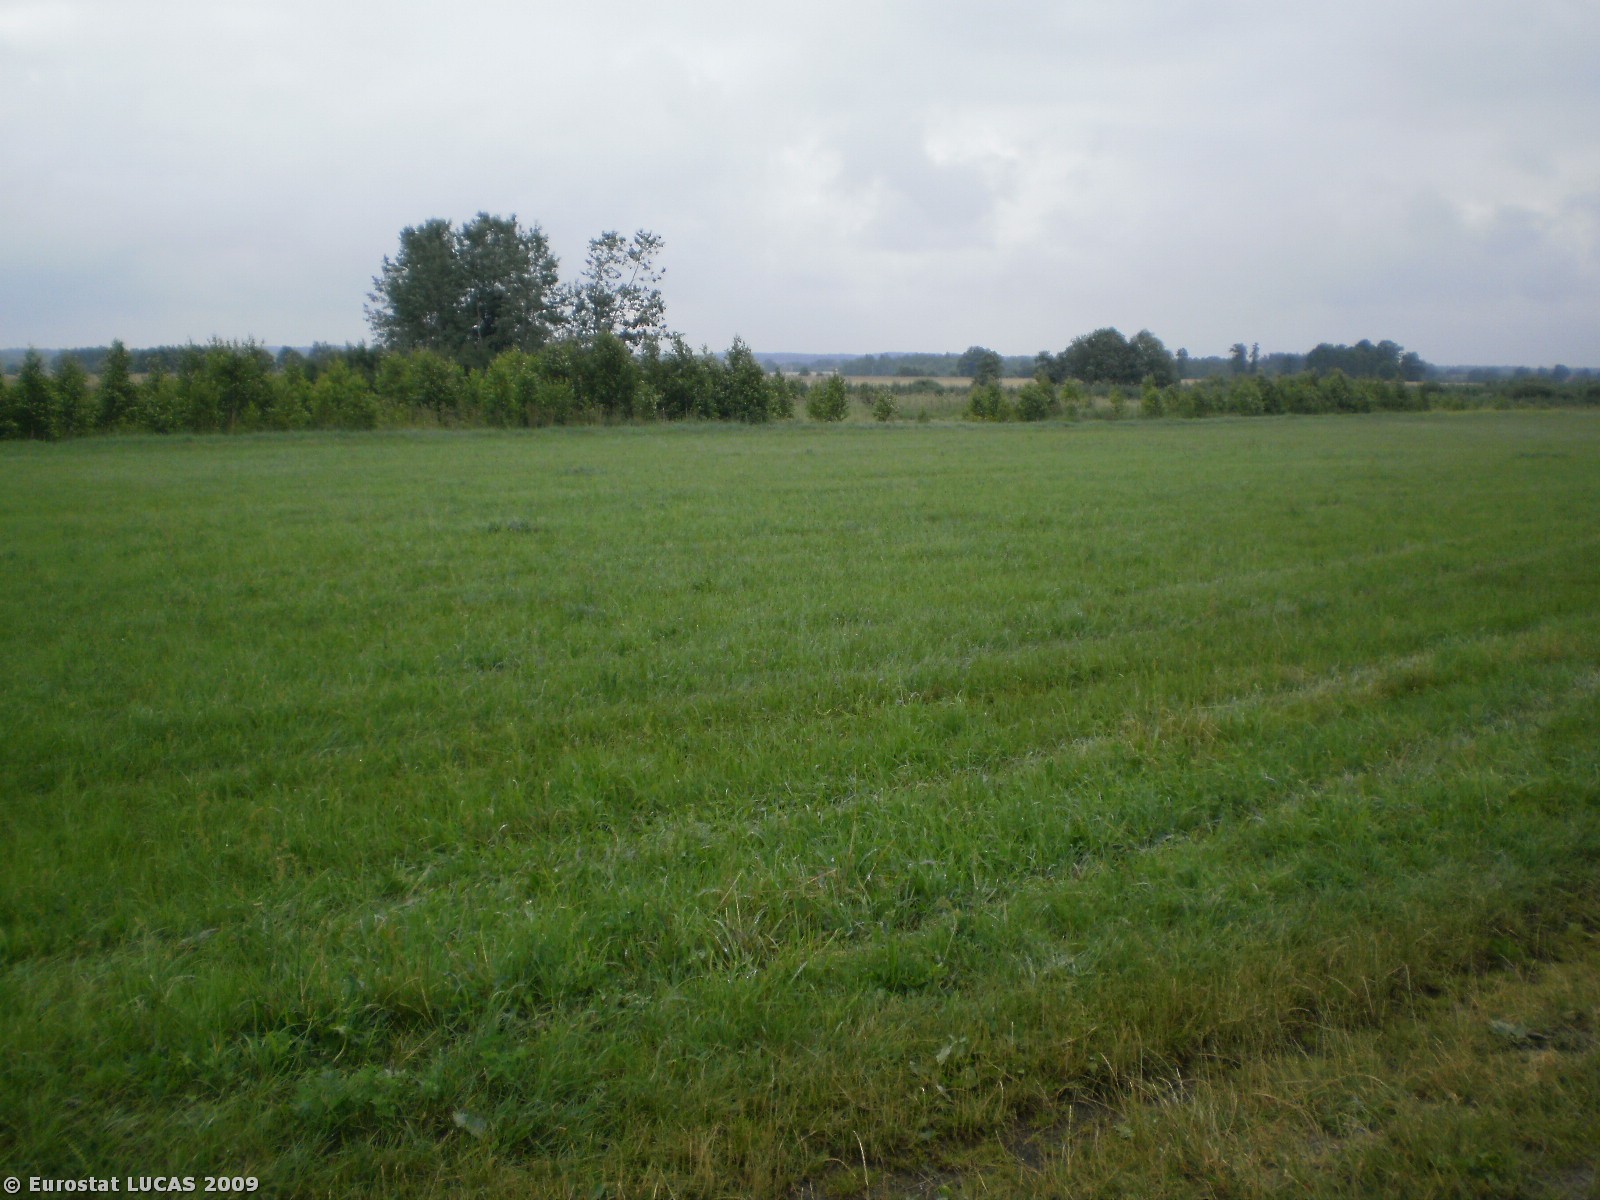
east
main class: Grassland
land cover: Grassland without tree/shrub cover
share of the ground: > 75 %
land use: Agriculture (excluding fallow land and kitchen gardens)
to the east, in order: Grassland without tree/shrub cover; Tracks; Grassland without tree/shrub cover; Coniferous woodland; Grass margins; Tracks; Grass margins; Triticale; Grassland without tree/shrub cover; Ditches and canals; Grassland without tree/shrub cover; Triticale
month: July
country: PL
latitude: 53.0940
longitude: 20.4454
